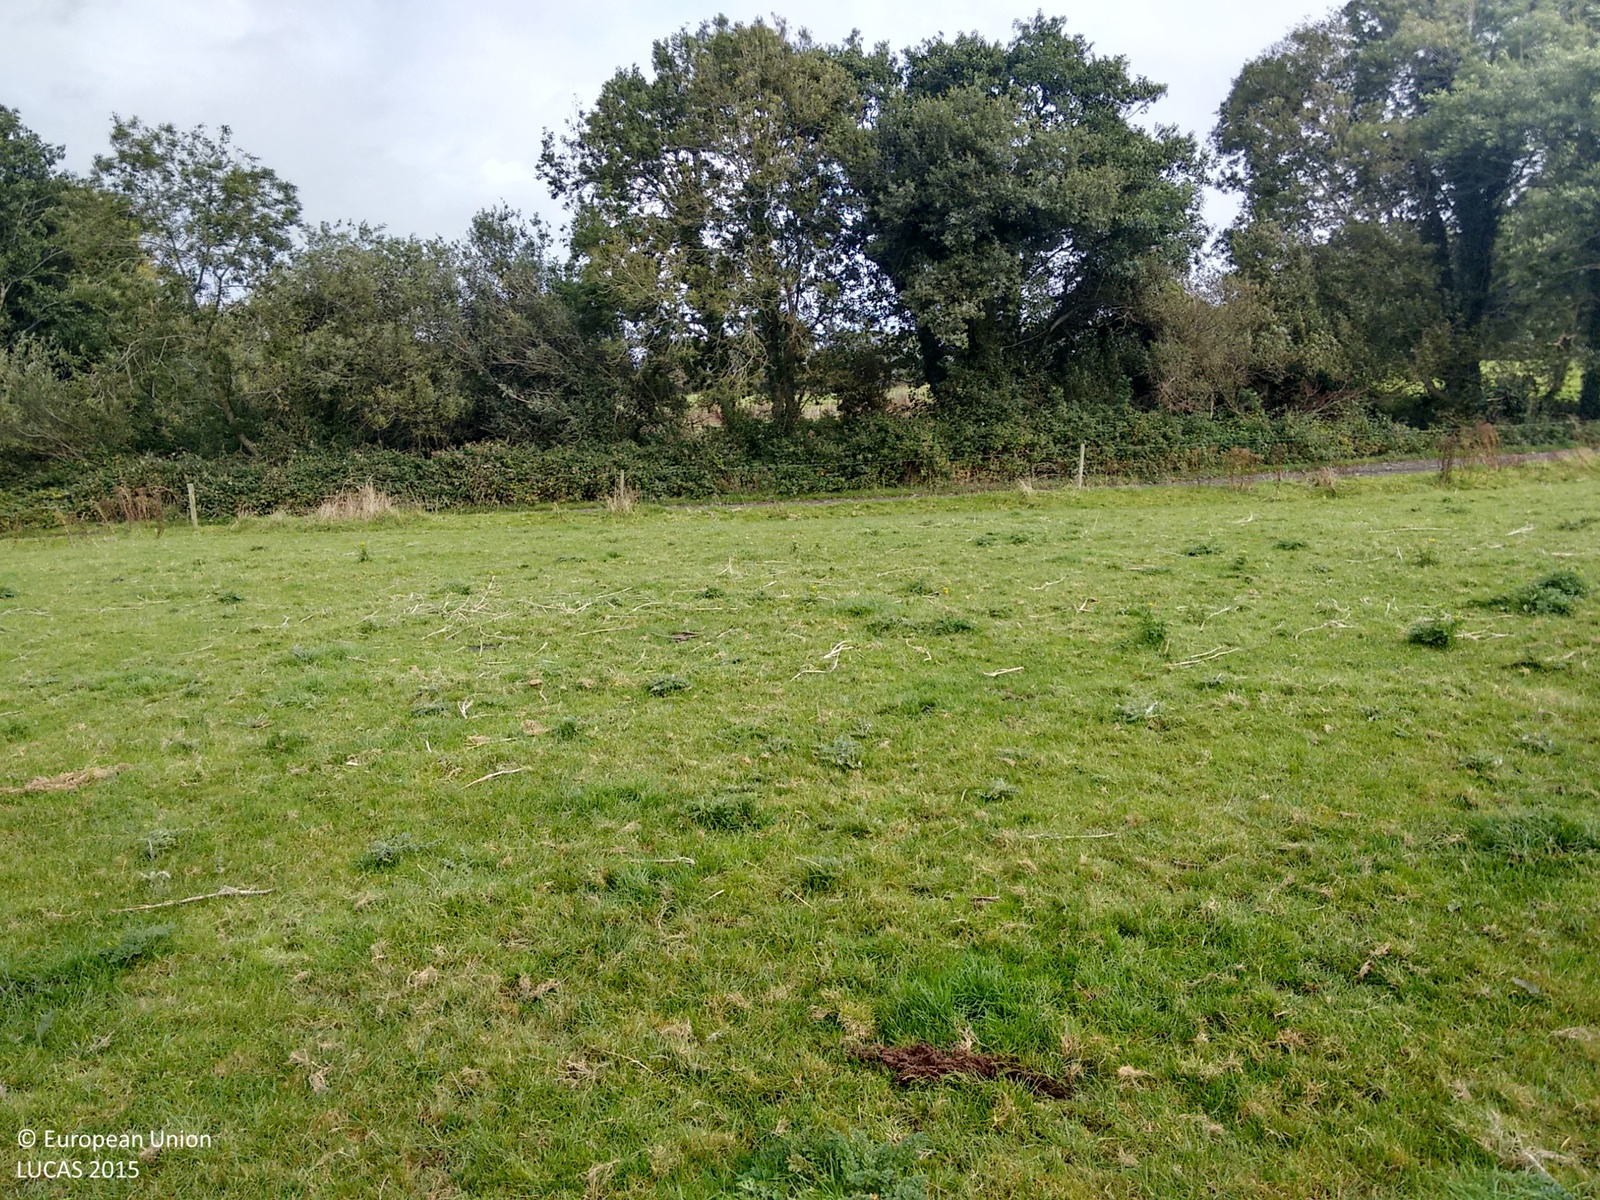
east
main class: Grassland
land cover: Grassland without tree/shrub cover
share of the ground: > 75 %
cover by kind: herbaceous plants 100 %
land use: Agriculture (excluding fallow land and kitchen gardens)
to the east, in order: Grassland without tree/shrub cover; Fences; Tracks; Abandoned hedges; Rivers and streams; Broadleaved woodland; Grassland without tree/shrub cover; Electric lines; Grassland without tree/shrub cover
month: September
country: IE
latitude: 52.5672
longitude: -9.3010
